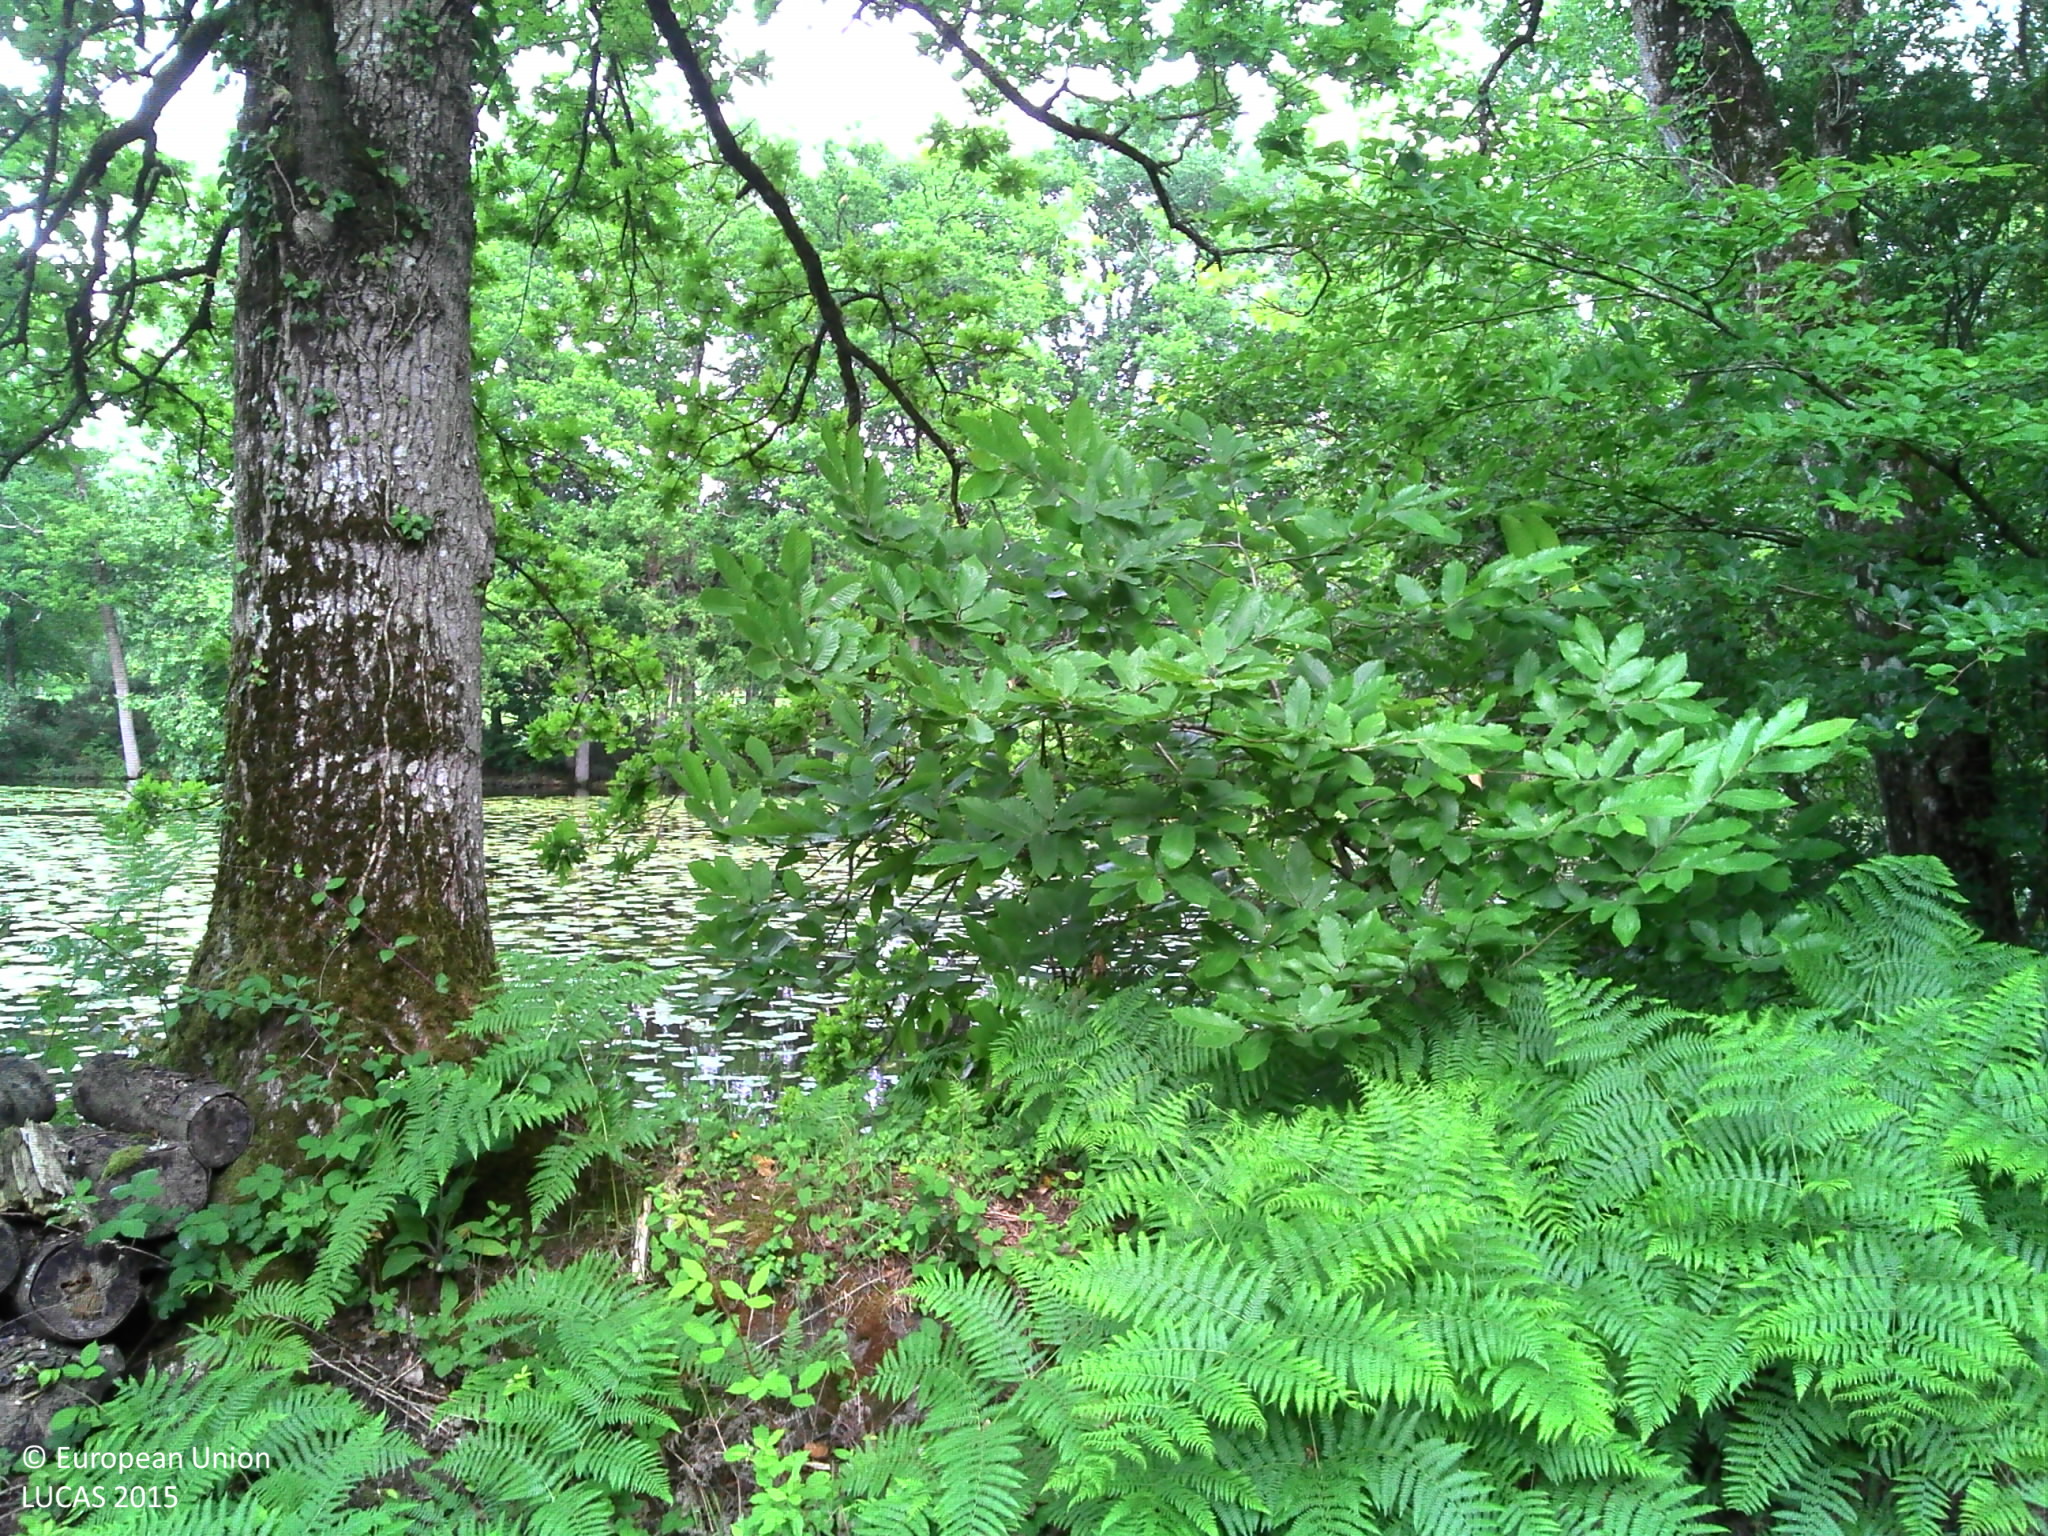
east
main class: Woodland
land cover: Spruce dominated mixed woodland
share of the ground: > 75 %
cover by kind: broadleaved forest trees 55 %, coniferous forest trees 40 %, herbaceous plants 5 %
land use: Semi-natural and natural areas not in use
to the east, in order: Spruce dominated mixed woodland; Fences; Tracks; Abandoned hedges; Inland fresh water bodies; Broadleaved woodland; Grassland without tree/shrub cover; Tracks; Grassland without tree/shrub cover; Single bushes/trees; Grassland without tree/shrub cover; Grassland with sparse tree/shrub cover; Grassland without tree/shrub cover
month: June
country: FR
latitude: 48.4861
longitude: -1.7265
